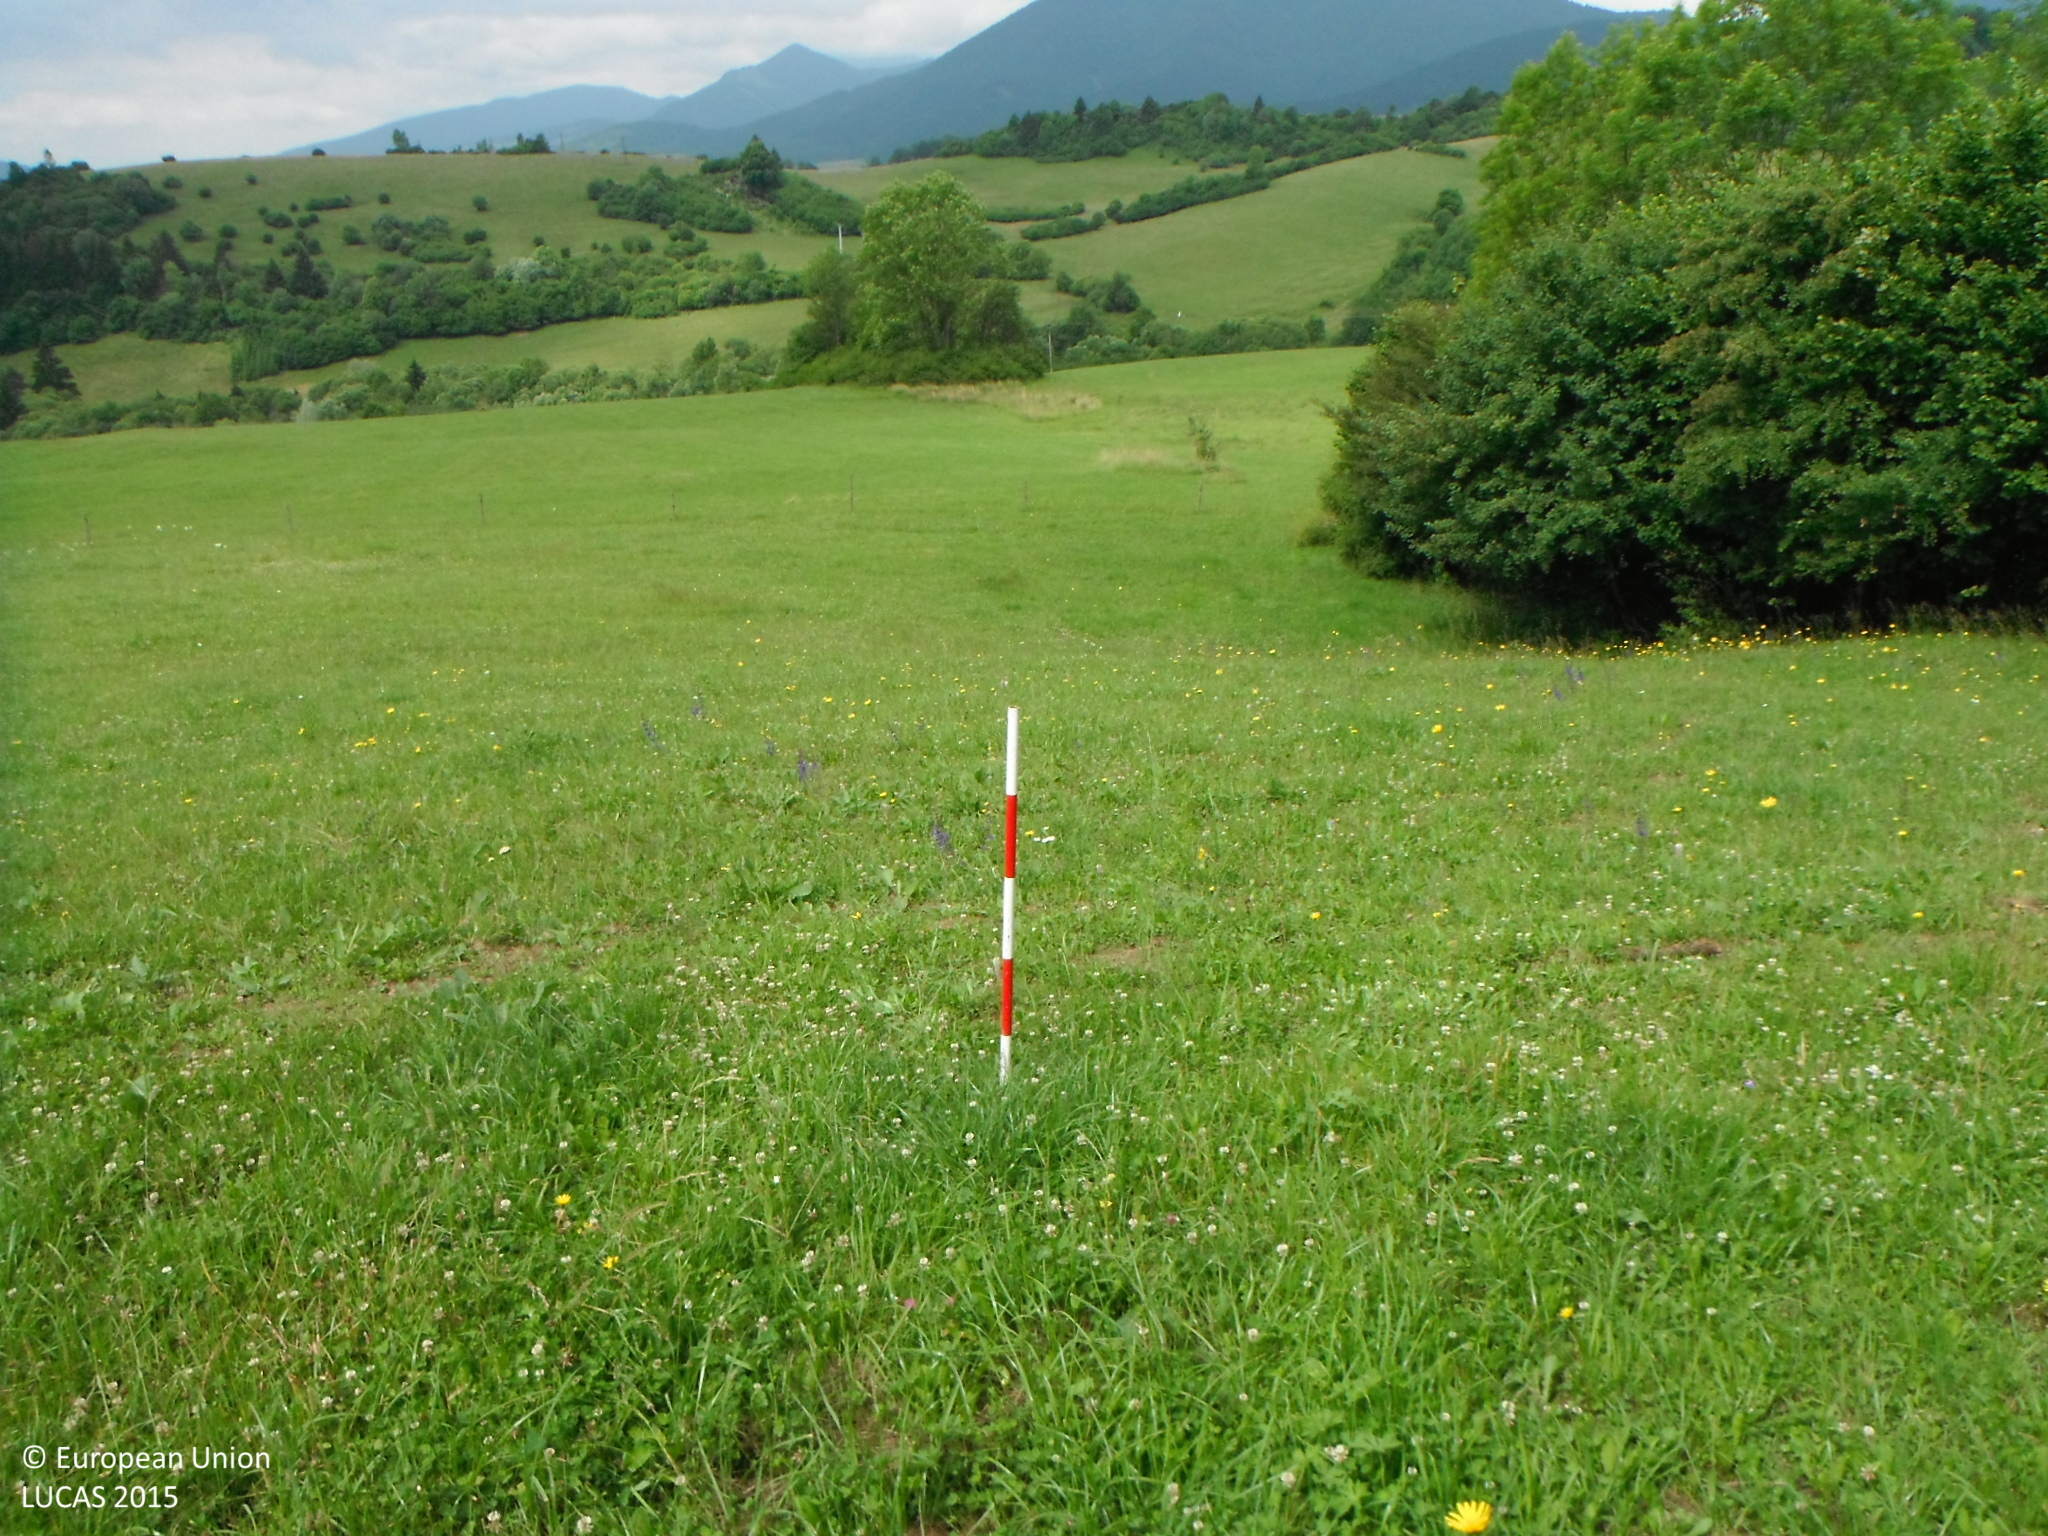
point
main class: Grassland
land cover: Grassland without tree/shrub cover
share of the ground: > 75 %
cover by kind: herbaceous plants 100 %
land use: Agriculture (excluding fallow land and kitchen gardens)
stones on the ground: < 10 %
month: June
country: SK
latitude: 49.2269
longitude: 19.2655
